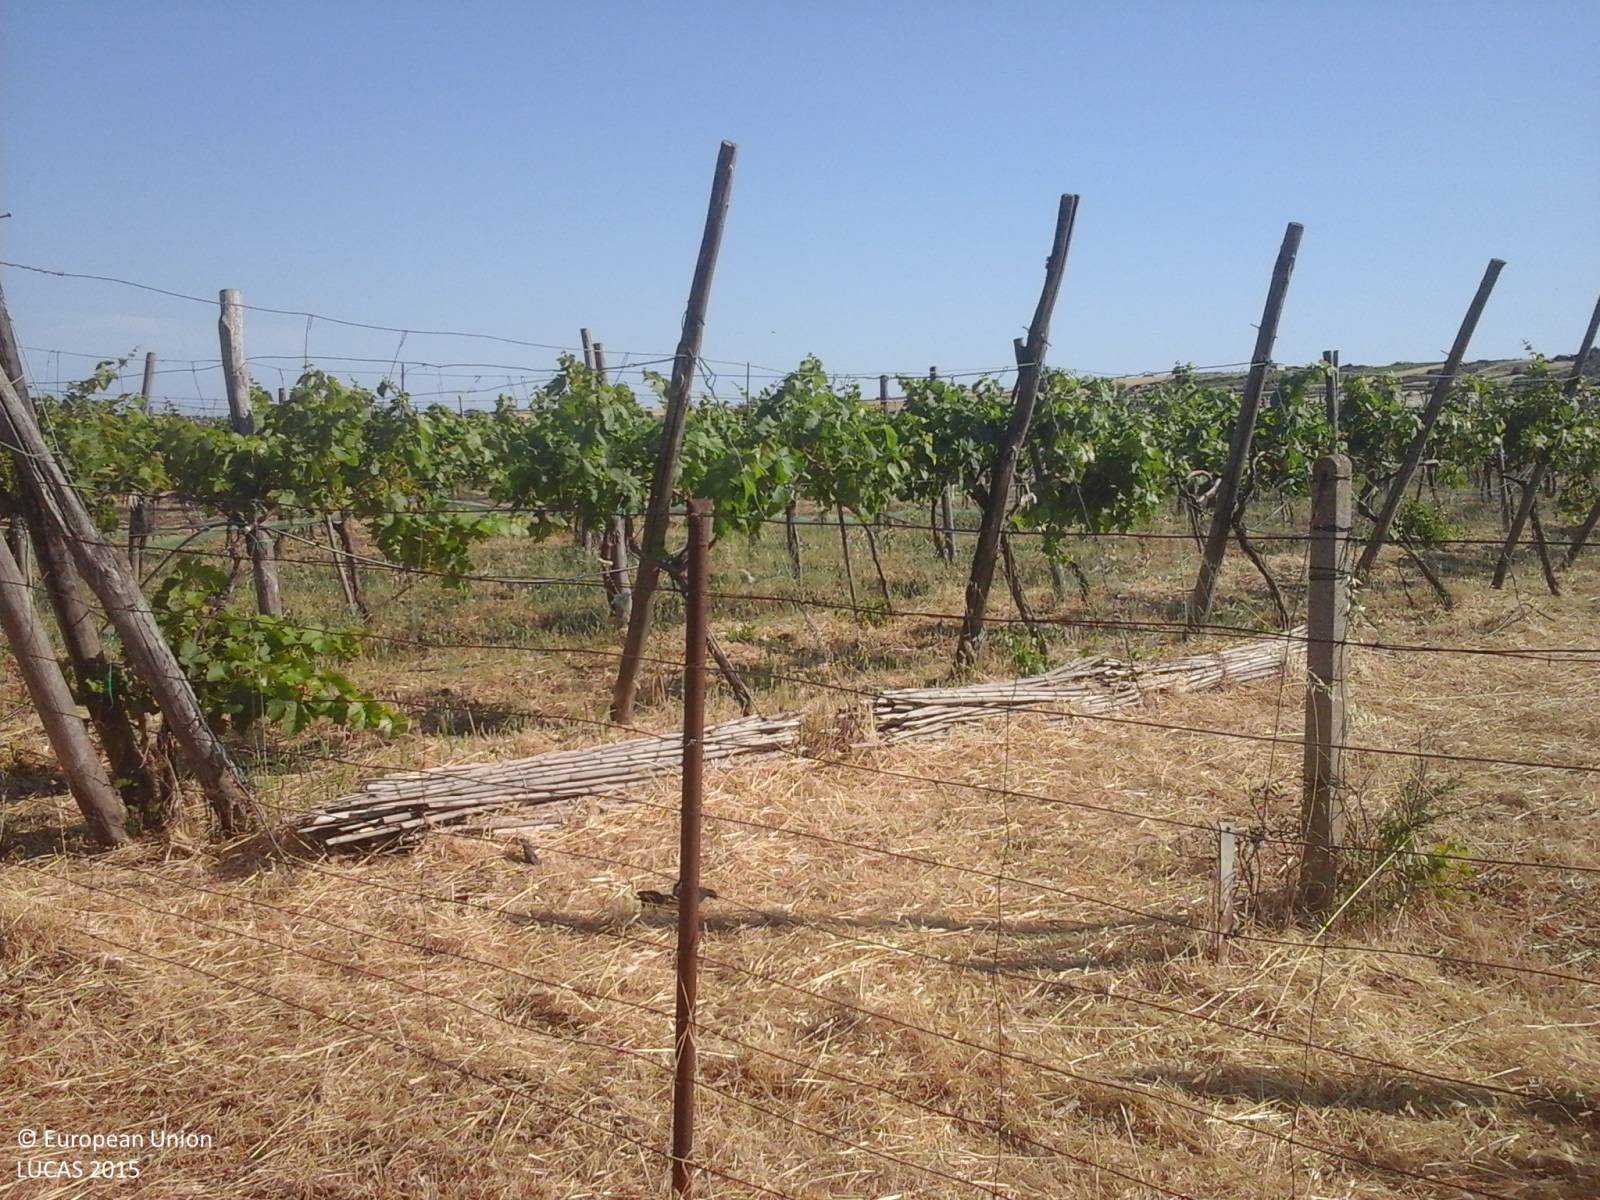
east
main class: Cropland
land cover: Vineyards
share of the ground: 50 - 75 %
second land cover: Oats
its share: 50 - 75 %
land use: Agriculture (excluding fallow land and kitchen gardens)
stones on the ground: 25 - 50 %
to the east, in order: Vineyards; Oats; Tracks; Oats; Tracks; Grassland without tree/shrub cover; Tracks; Olive groves; Vineyards
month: June
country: IT
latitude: 39.2864
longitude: 9.2510
